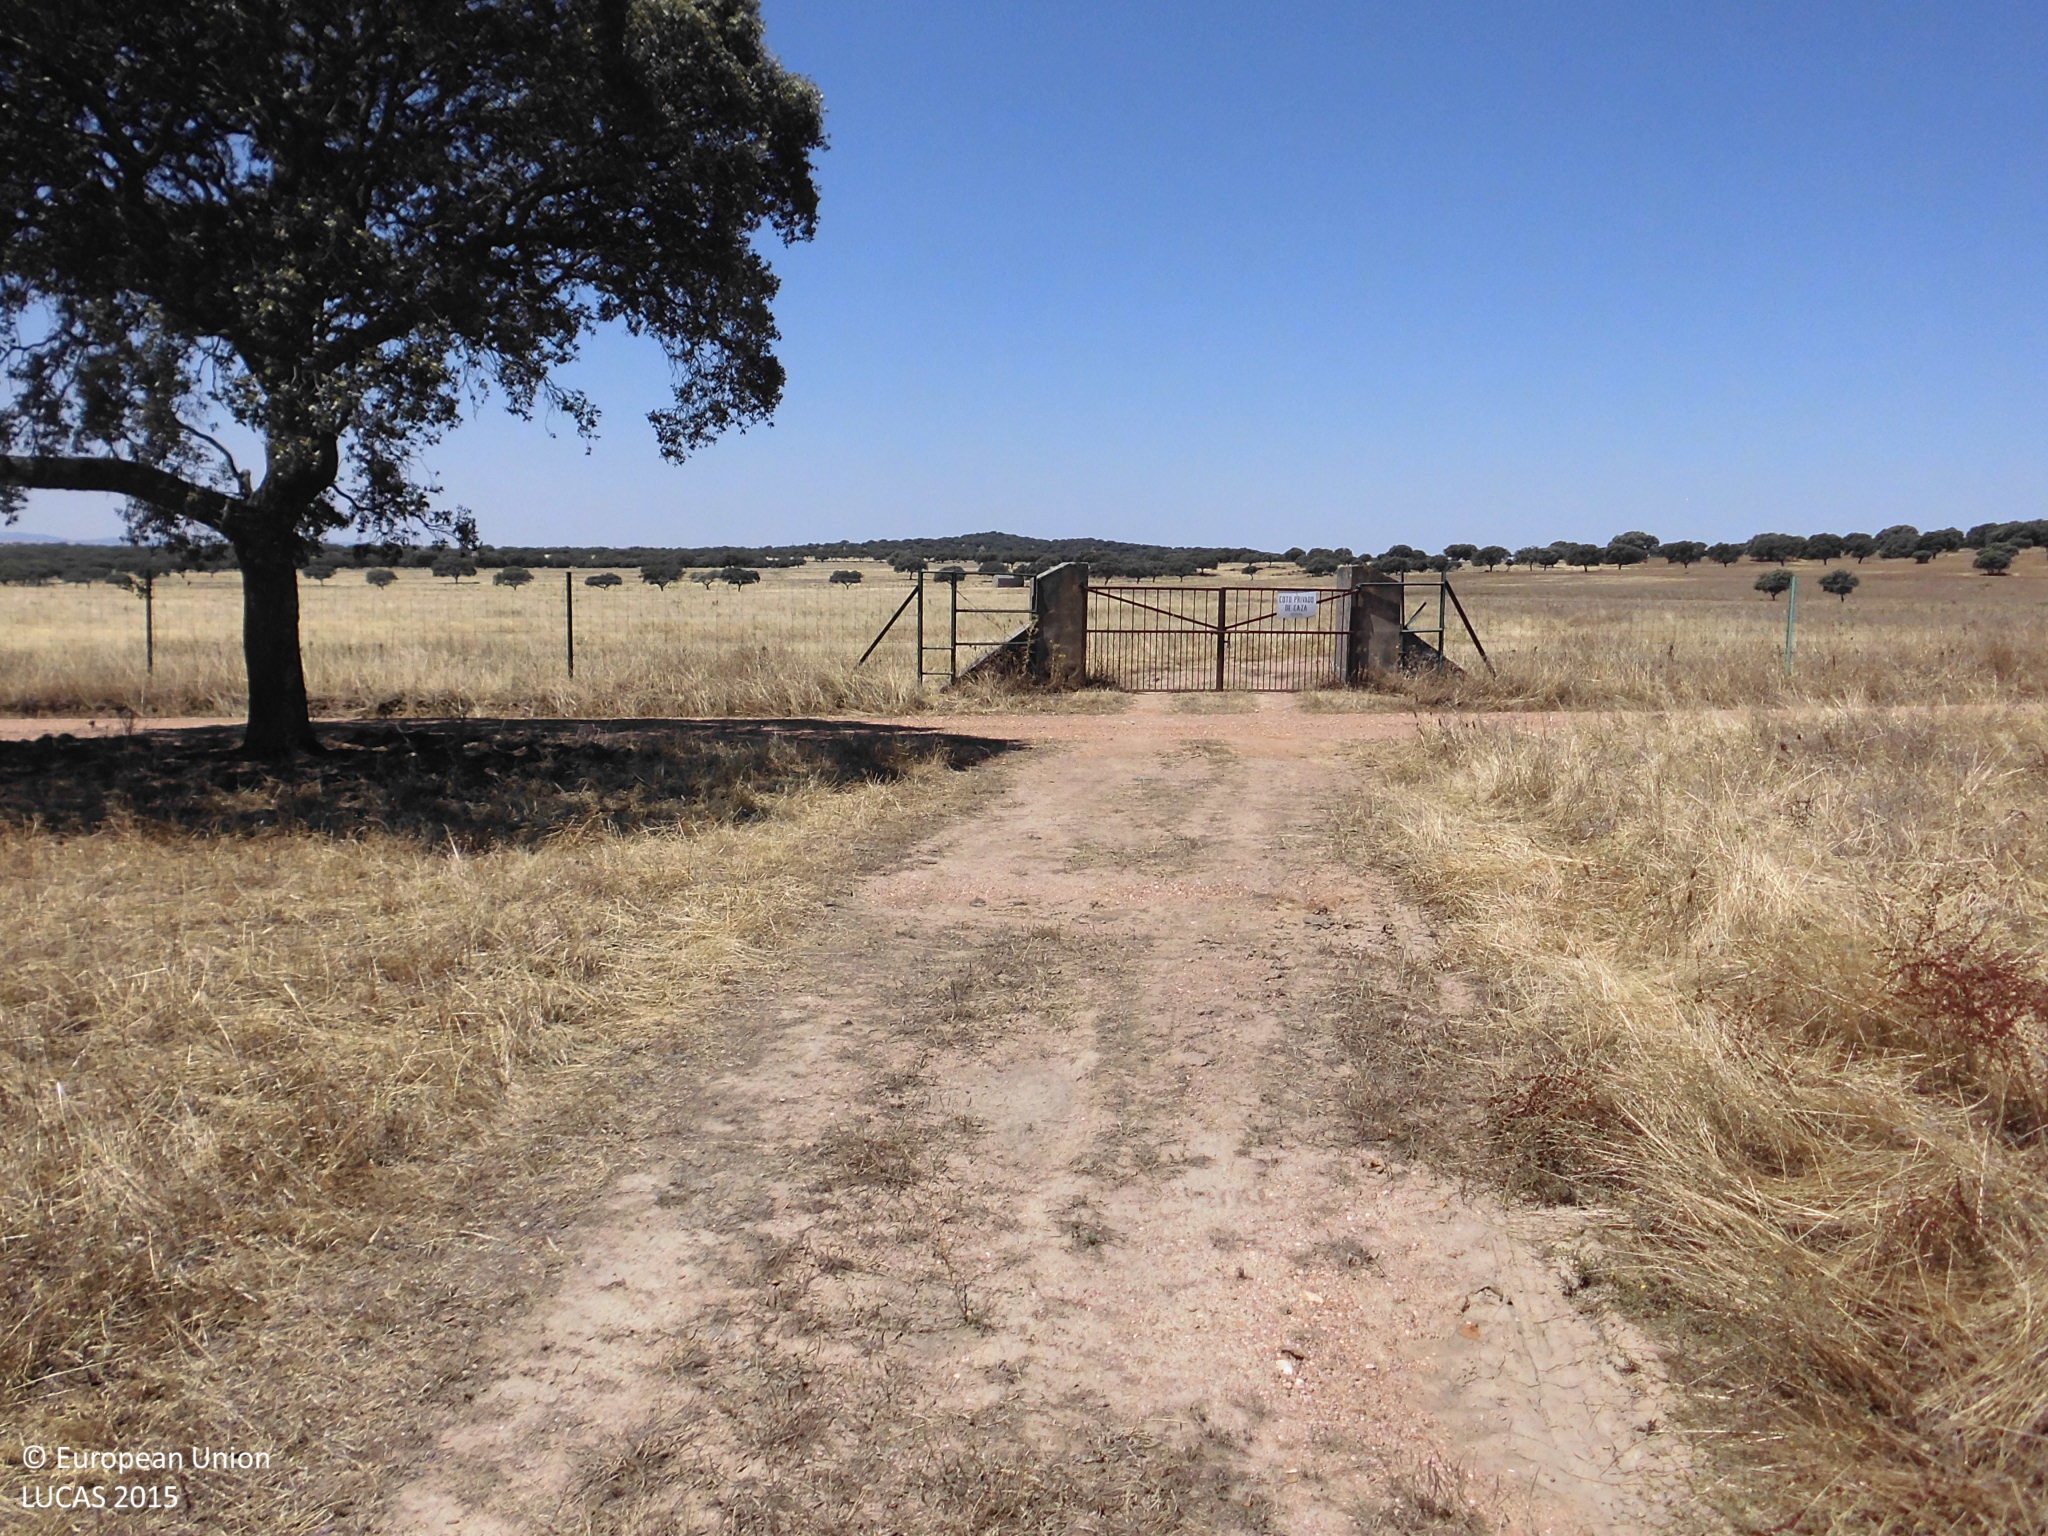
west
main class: Woodland
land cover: Broadleaved woodland
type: broadleaved evergreen forest
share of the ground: 10 - 25 %
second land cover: Grassland without tree/shrub cover
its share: > 75 %
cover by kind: herbaceous plants 75 %, broadleaved forest trees 25 %
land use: Forestry
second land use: Agriculture (excluding fallow land and kitchen gardens)
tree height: > 5 m
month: June
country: ES
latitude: 39.6981
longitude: -6.0065
